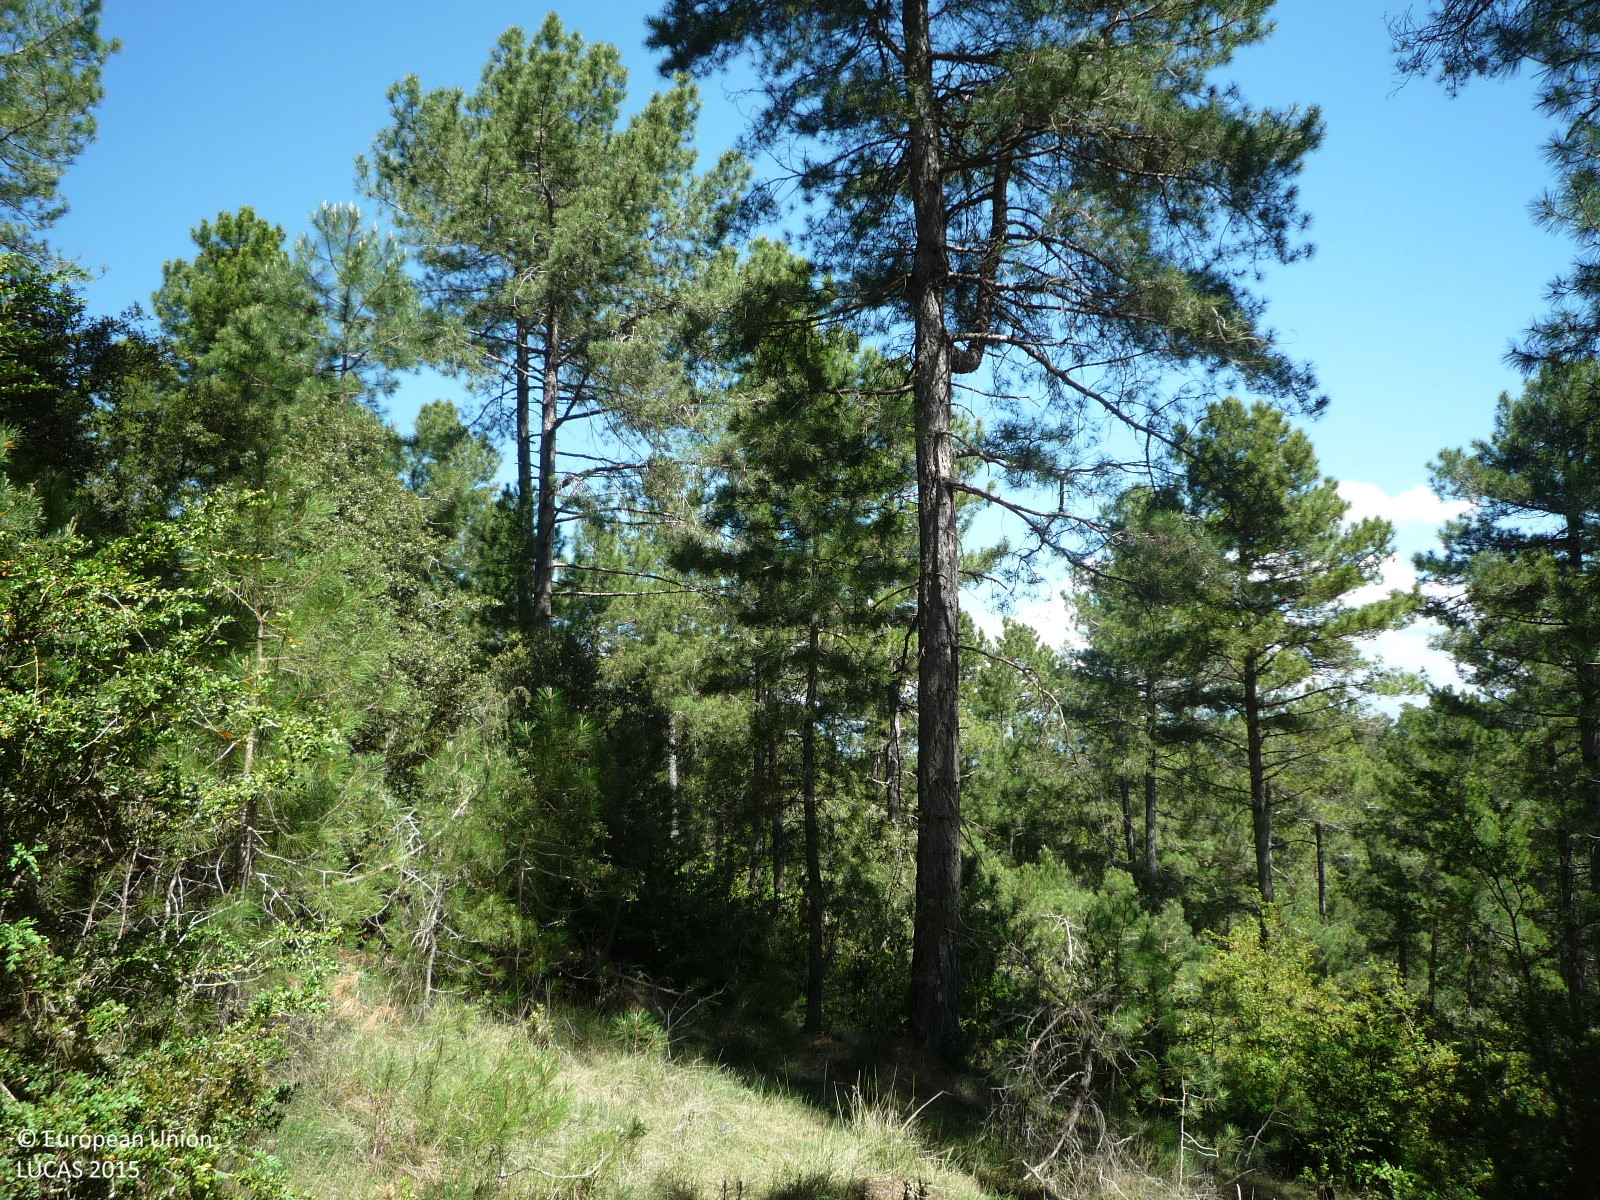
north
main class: Woodland
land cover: Pine dominated coniferous woodland
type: coniferous forest of the mediterranean region
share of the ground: > 75 %
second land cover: Spontaneously vegetated surfaces
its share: 25 - 50 %
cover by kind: coniferous forest trees 90 %, shrubs 10 %
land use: Forestry
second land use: Agriculture (excluding fallow land and kitchen gardens)
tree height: > 5 m
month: May
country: ES
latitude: 41.8005
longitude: 1.6497
